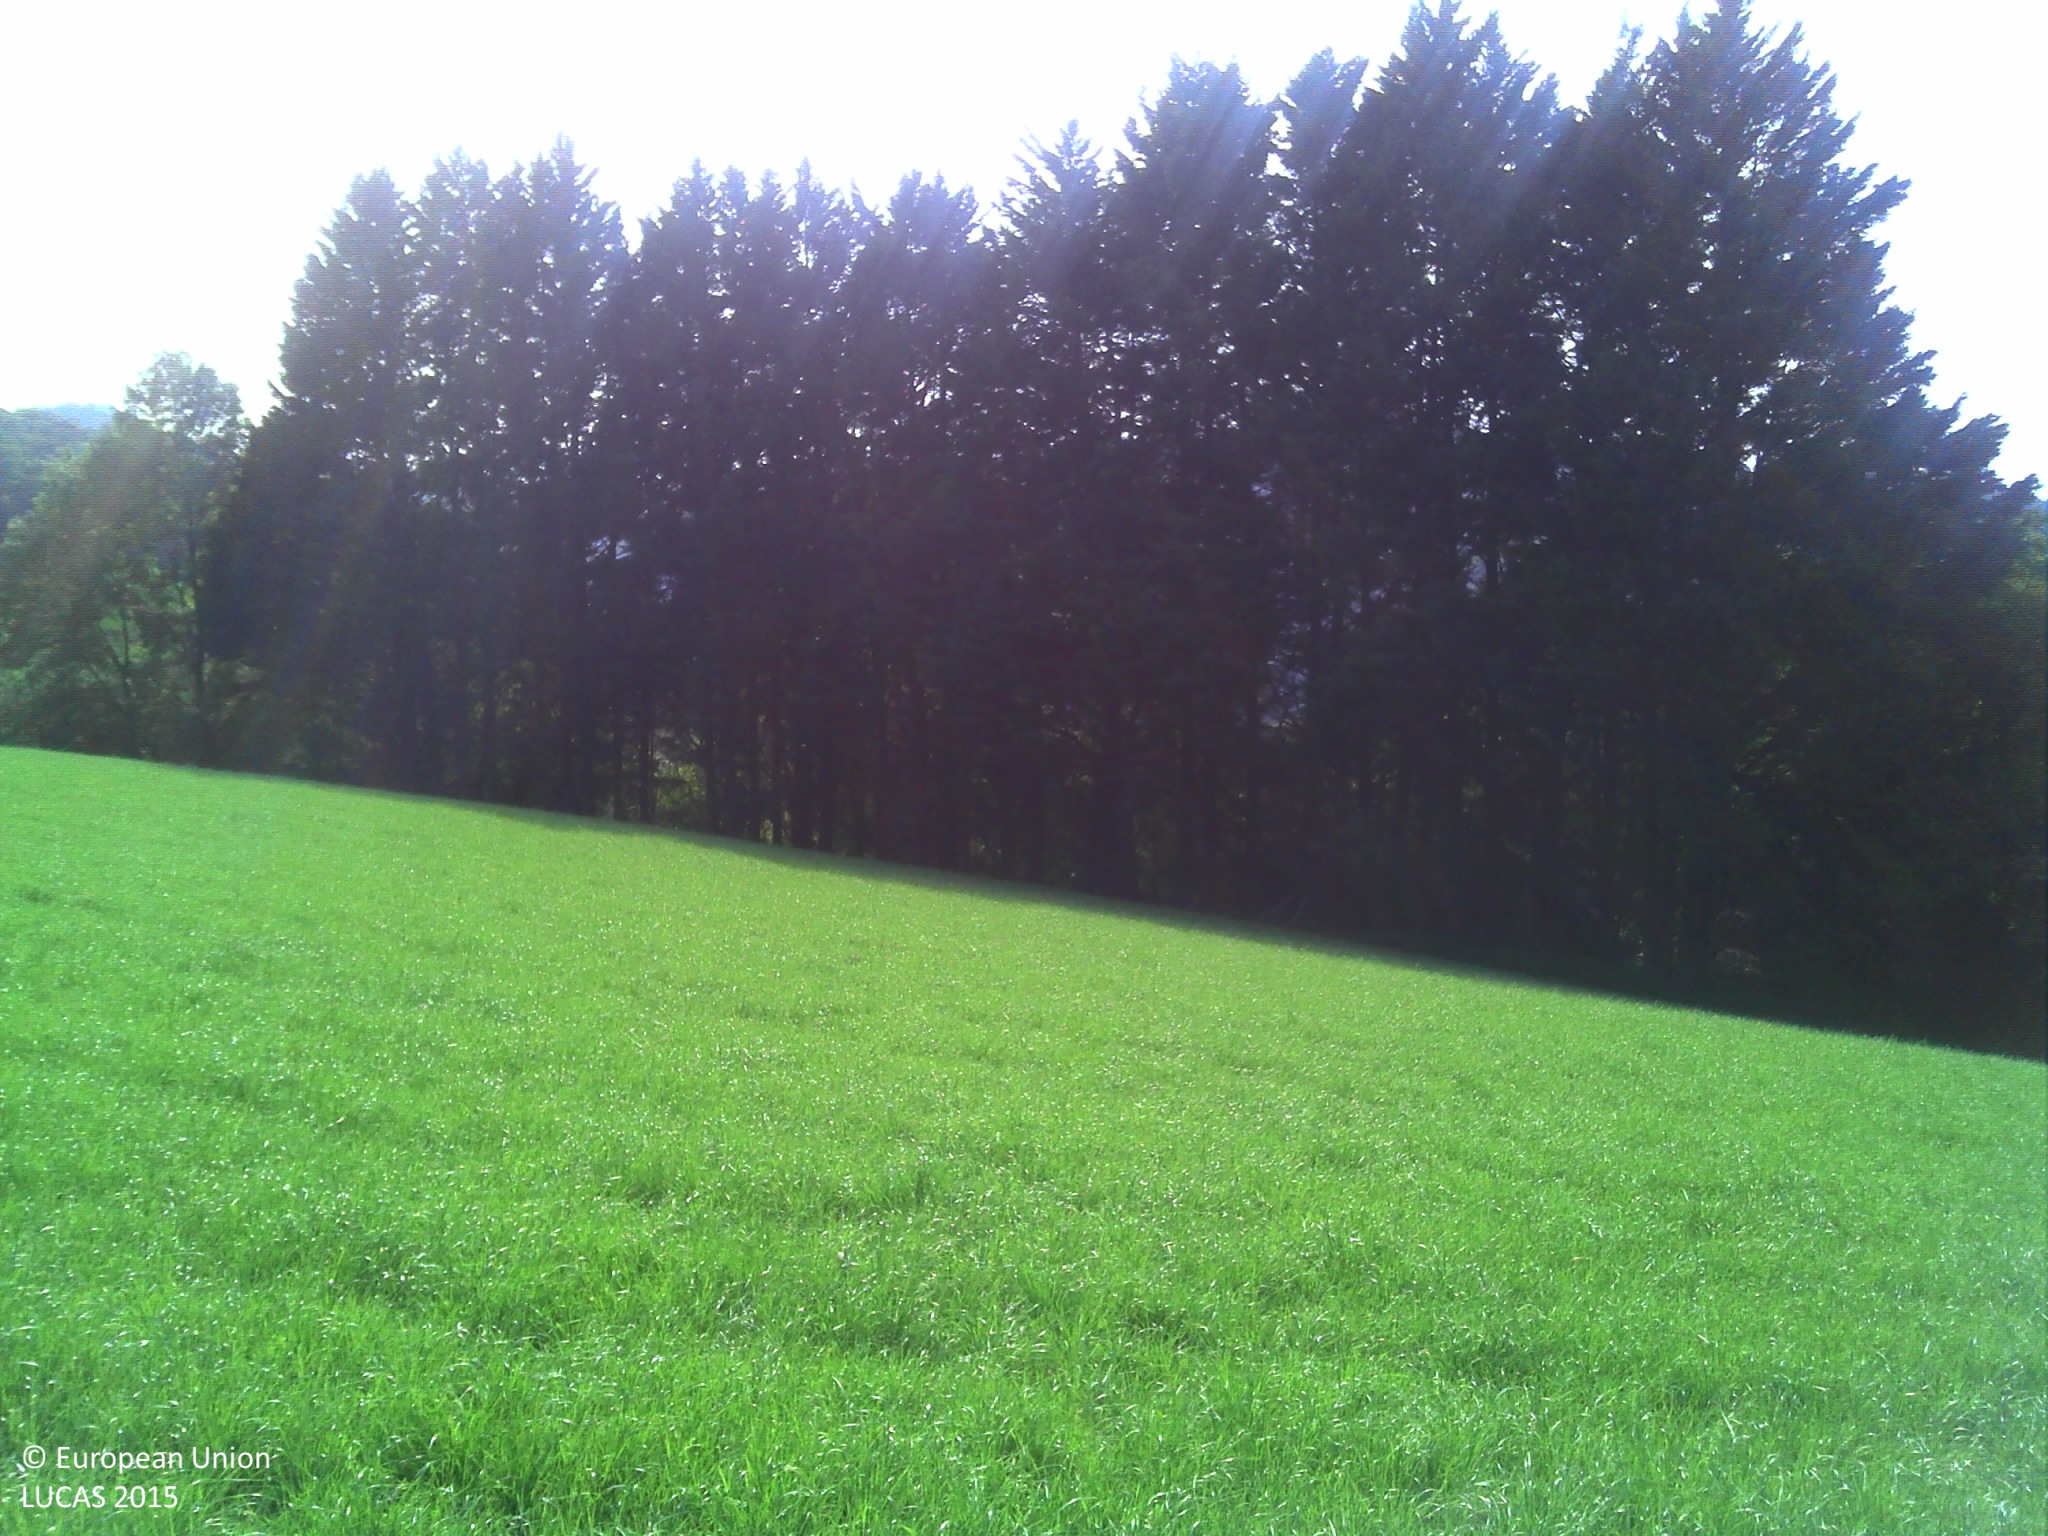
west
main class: Cropland
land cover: Temporary grasslands
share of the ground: > 75 %
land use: Agriculture (excluding fallow land and kitchen gardens)
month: September
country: FR
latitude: 43.1562
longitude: -1.0675
